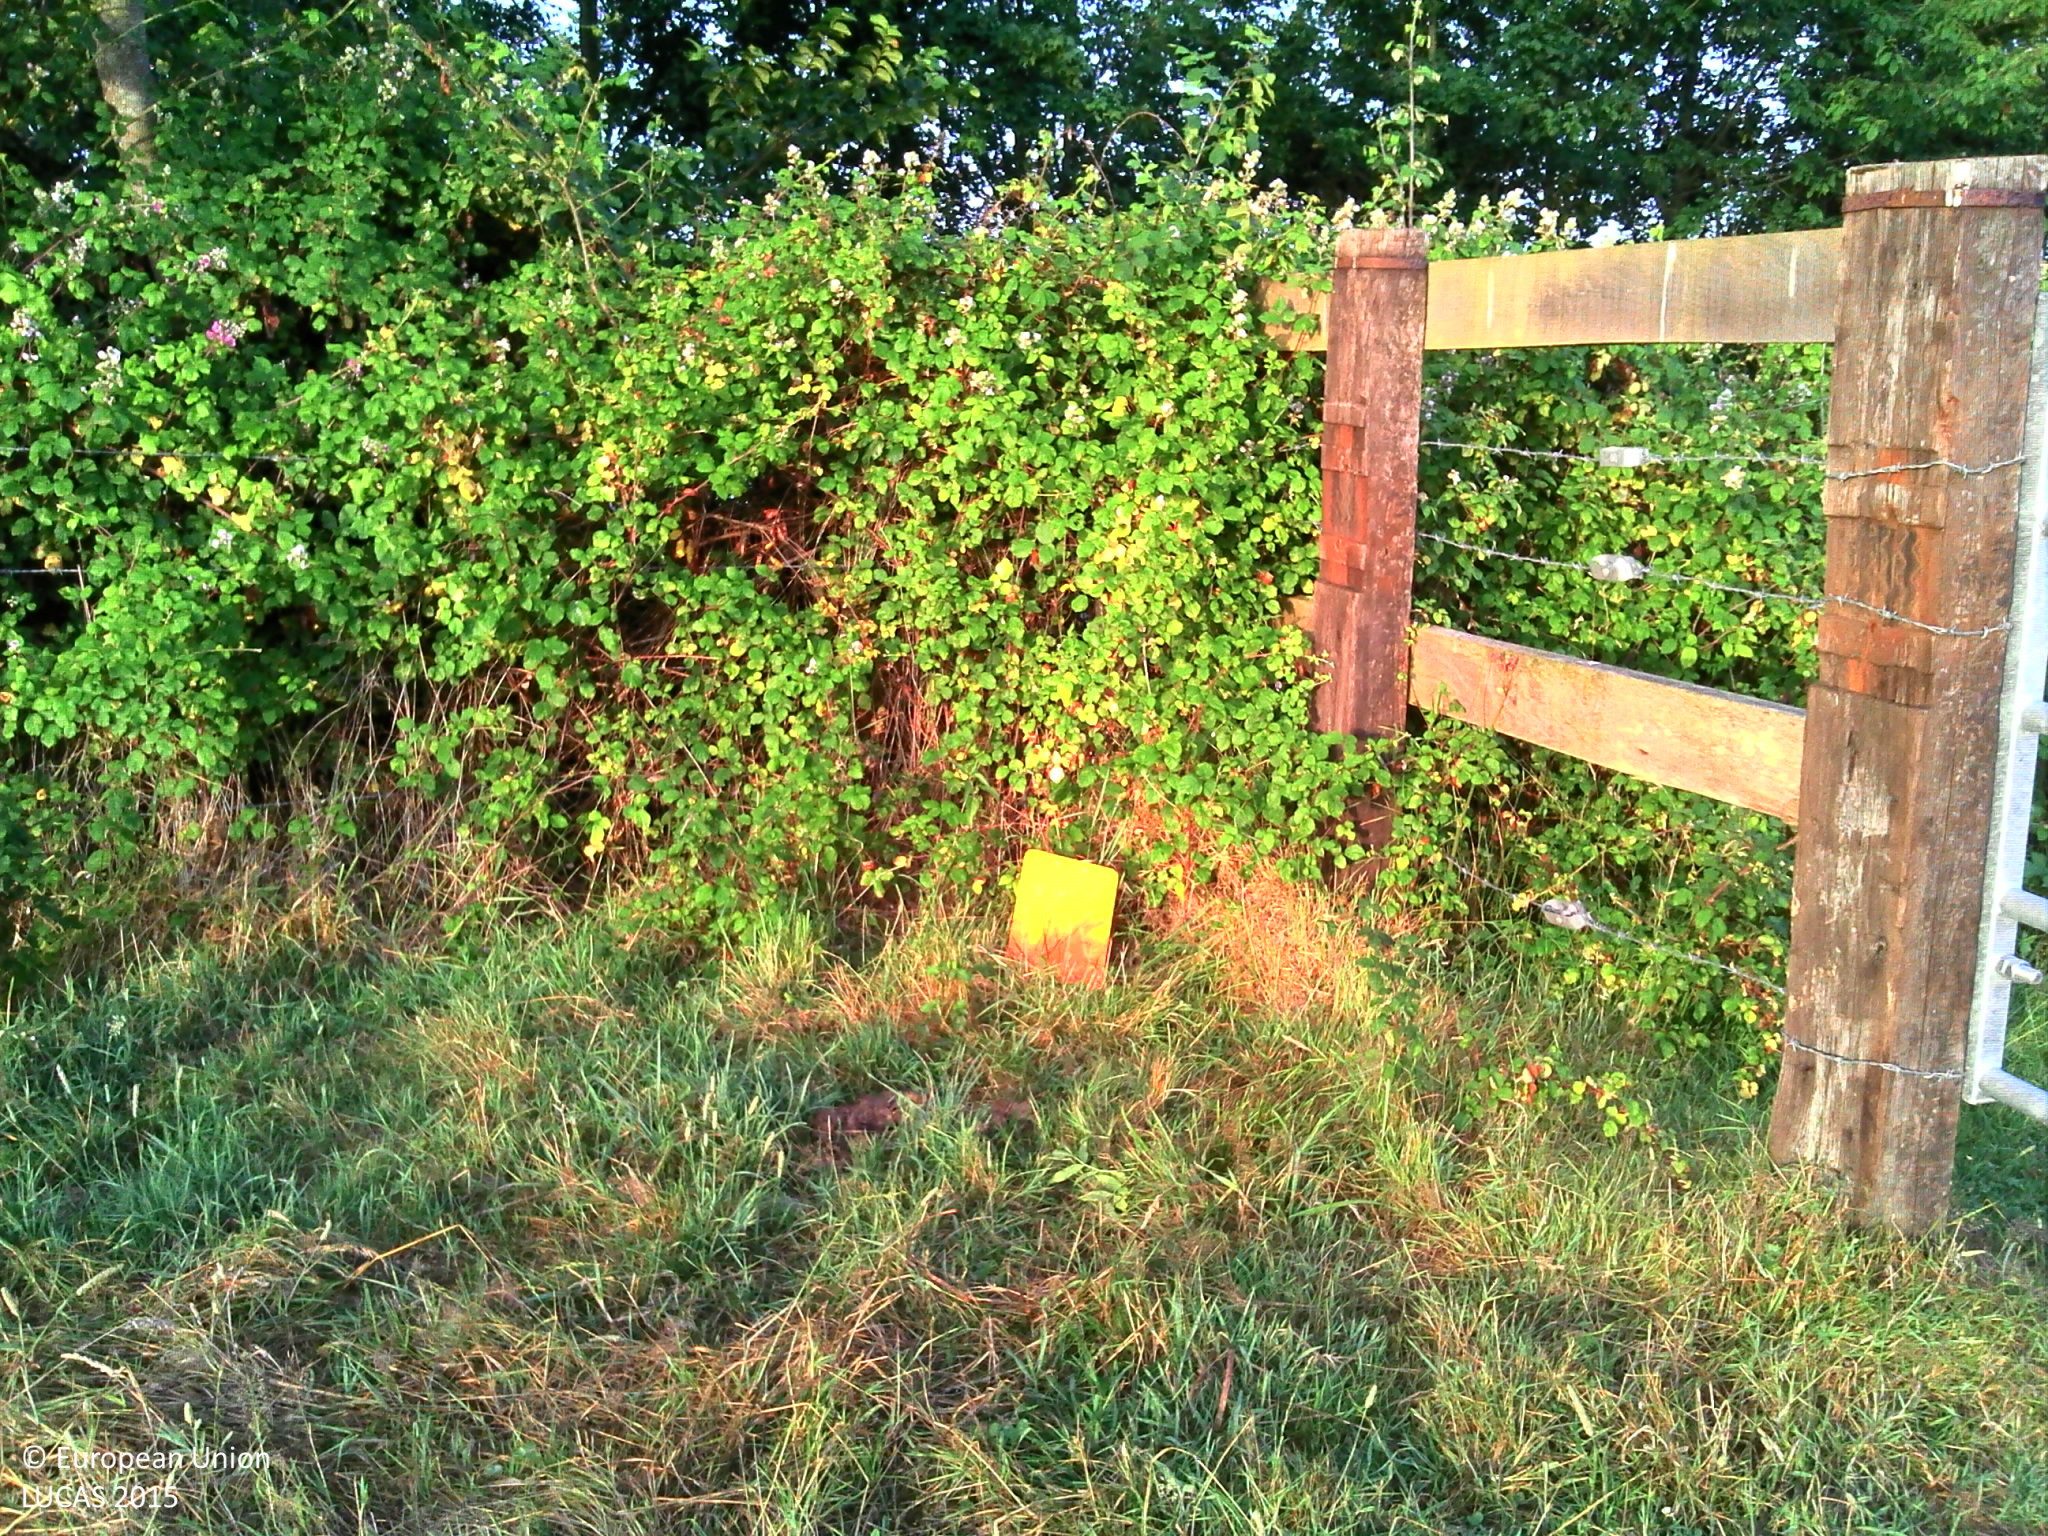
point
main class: Grassland
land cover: Grassland without tree/shrub cover
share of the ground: > 75 %
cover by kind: herbaceous plants 100 %
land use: Agriculture (excluding fallow land and kitchen gardens)
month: July
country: FR
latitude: 49.0947
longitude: 0.0407
